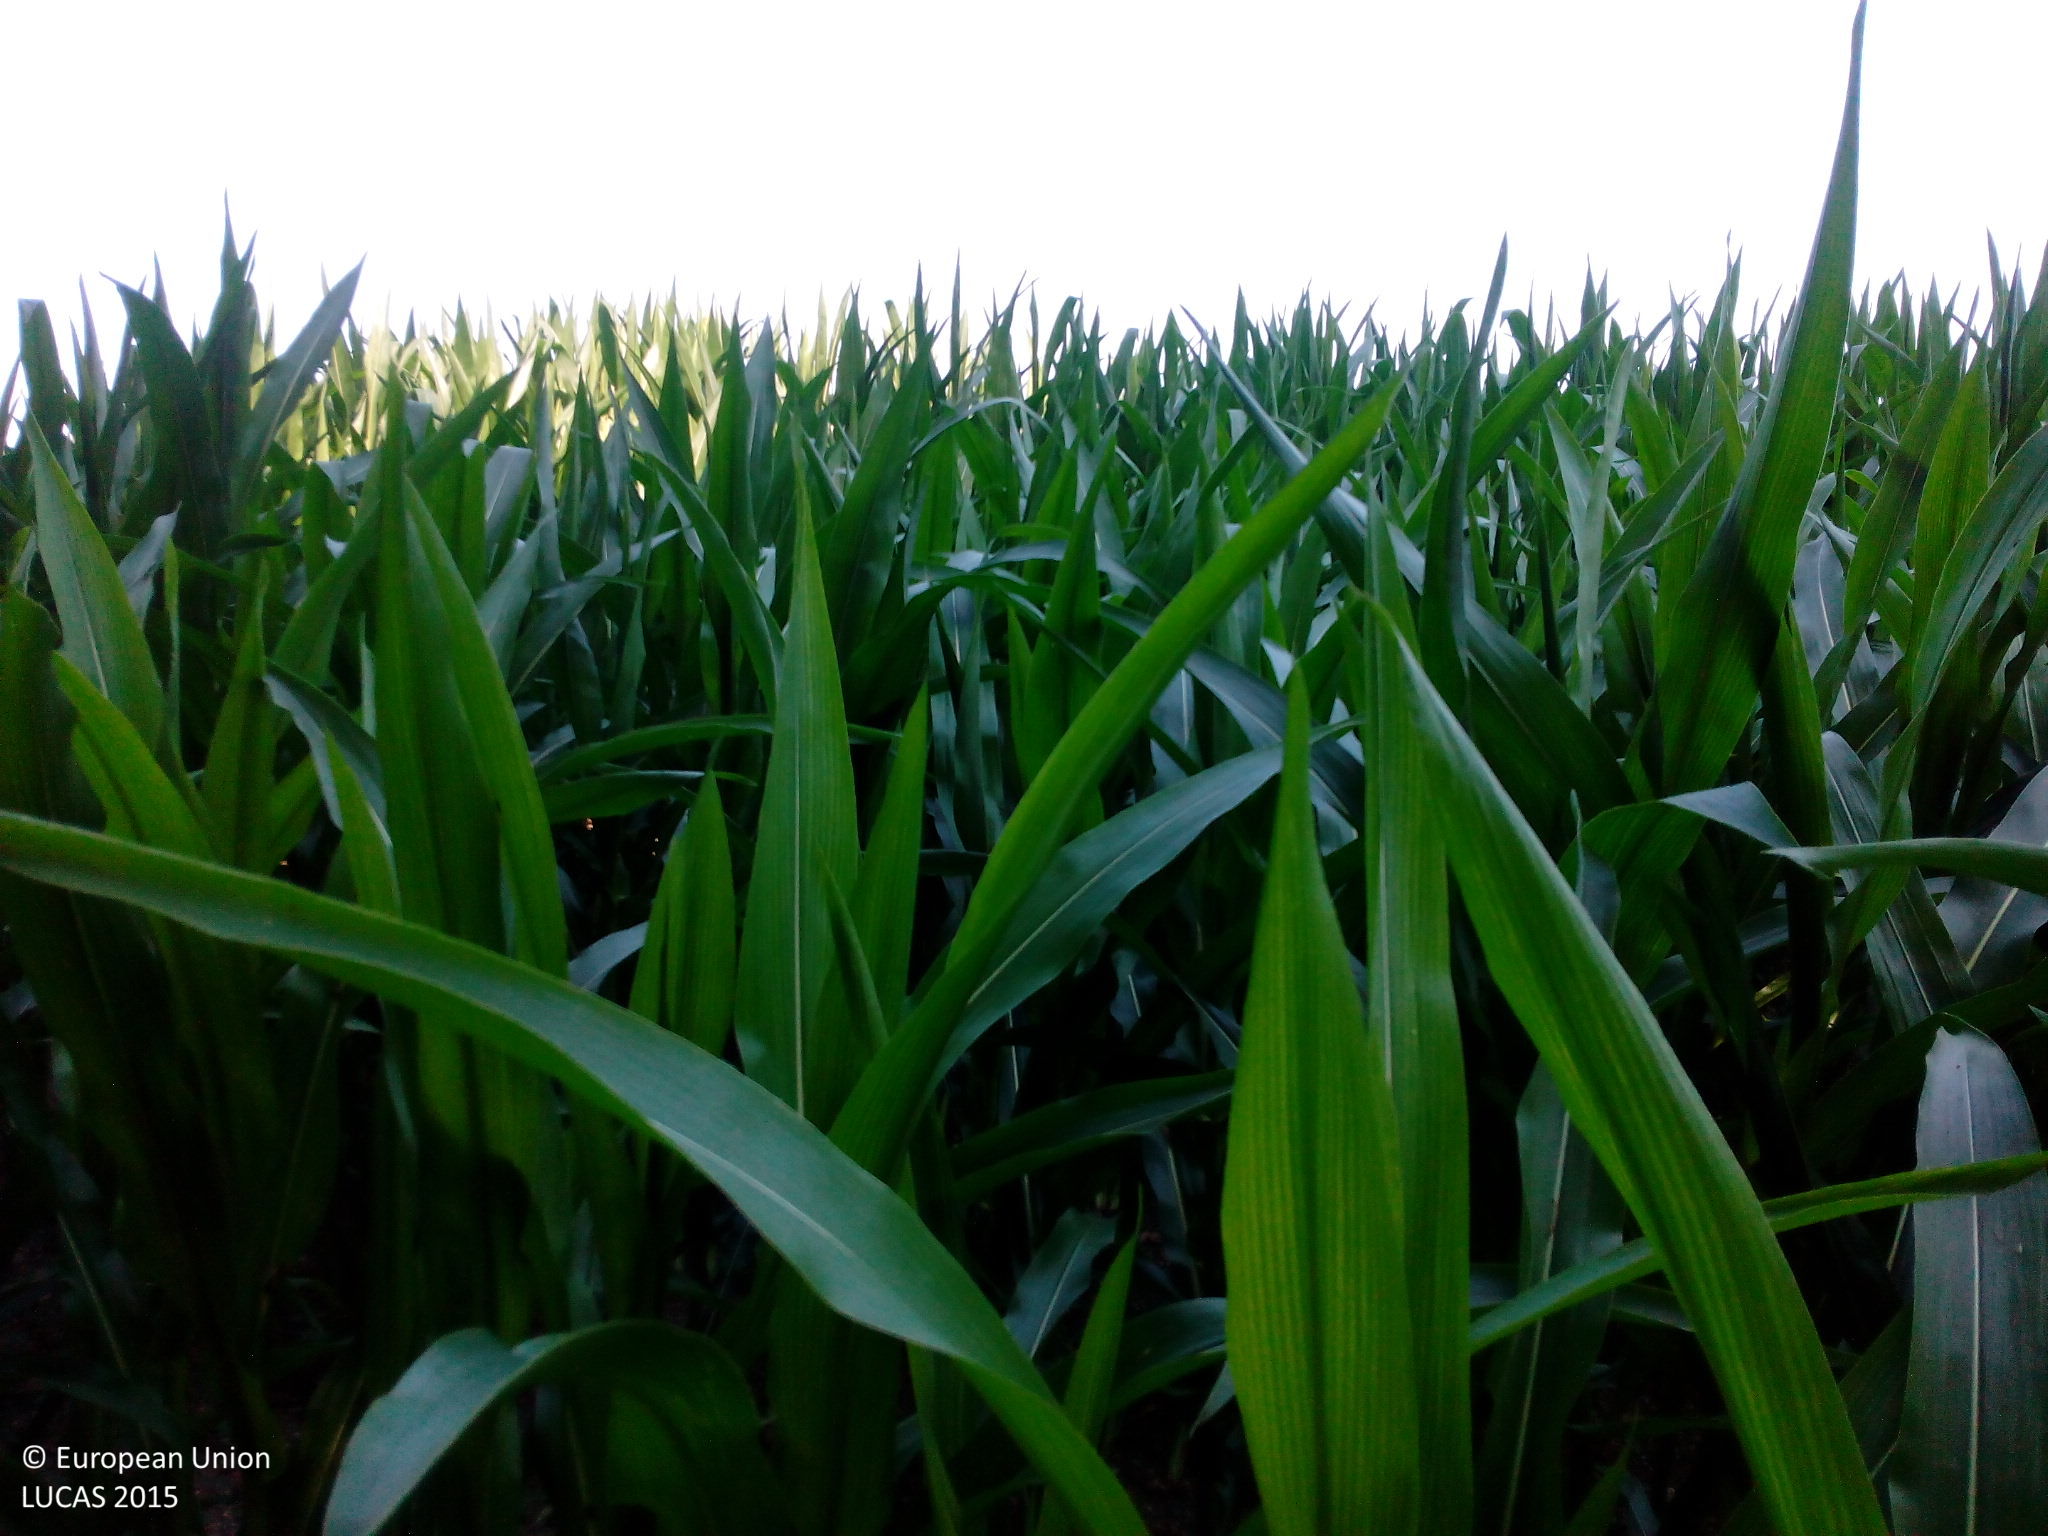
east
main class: Cropland
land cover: Maize
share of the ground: > 75 %
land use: Agriculture (excluding fallow land and kitchen gardens)
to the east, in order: Maize; Grass margins; Paved roads, cycling and walking lanes; Grass margins; Electric lines; Tracks; Grass margins; Maize
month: July
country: DE
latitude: 48.2216
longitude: 12.8930
